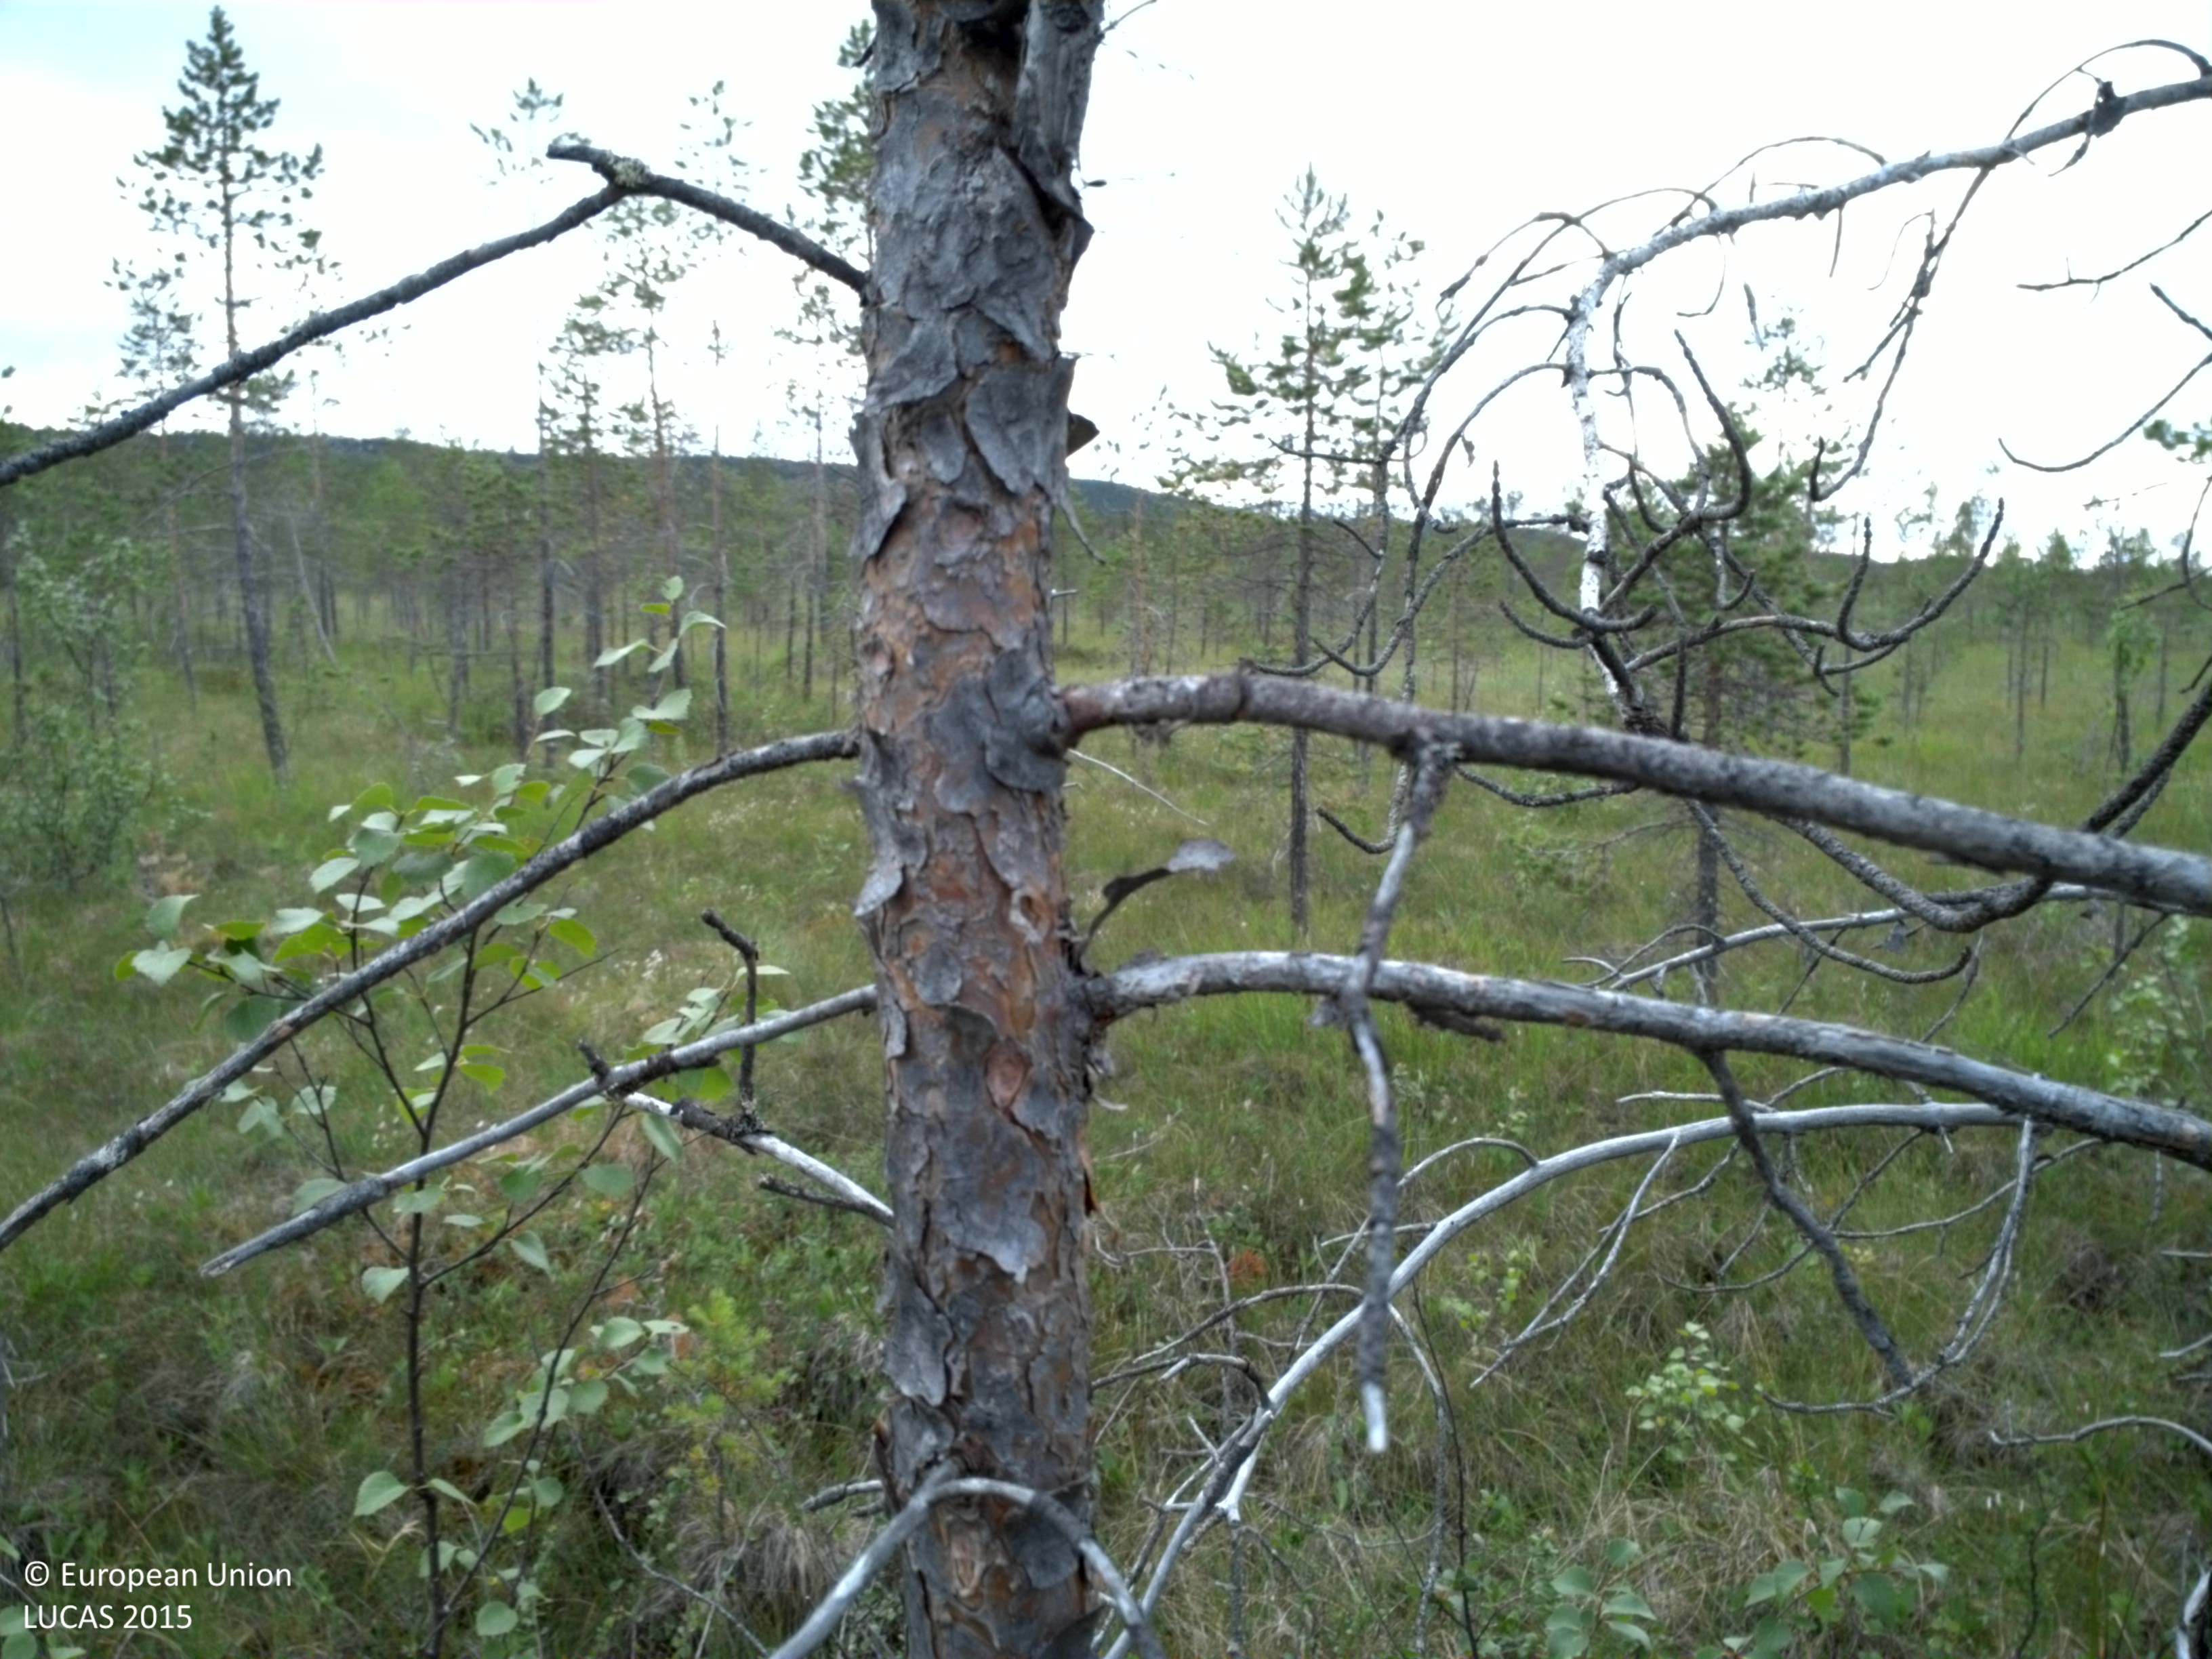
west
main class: Woodland
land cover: Pine dominated coniferous woodland
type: mire and swamp forests
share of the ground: 10 - 25 %
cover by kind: herbaceous plants 50 %, shrubs 30 %, coniferous forest trees 15 %, lichens and mosses 5 %
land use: Semi-natural and natural areas not in use
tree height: > 5 m
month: August
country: SE
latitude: 66.5678
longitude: 19.9361
